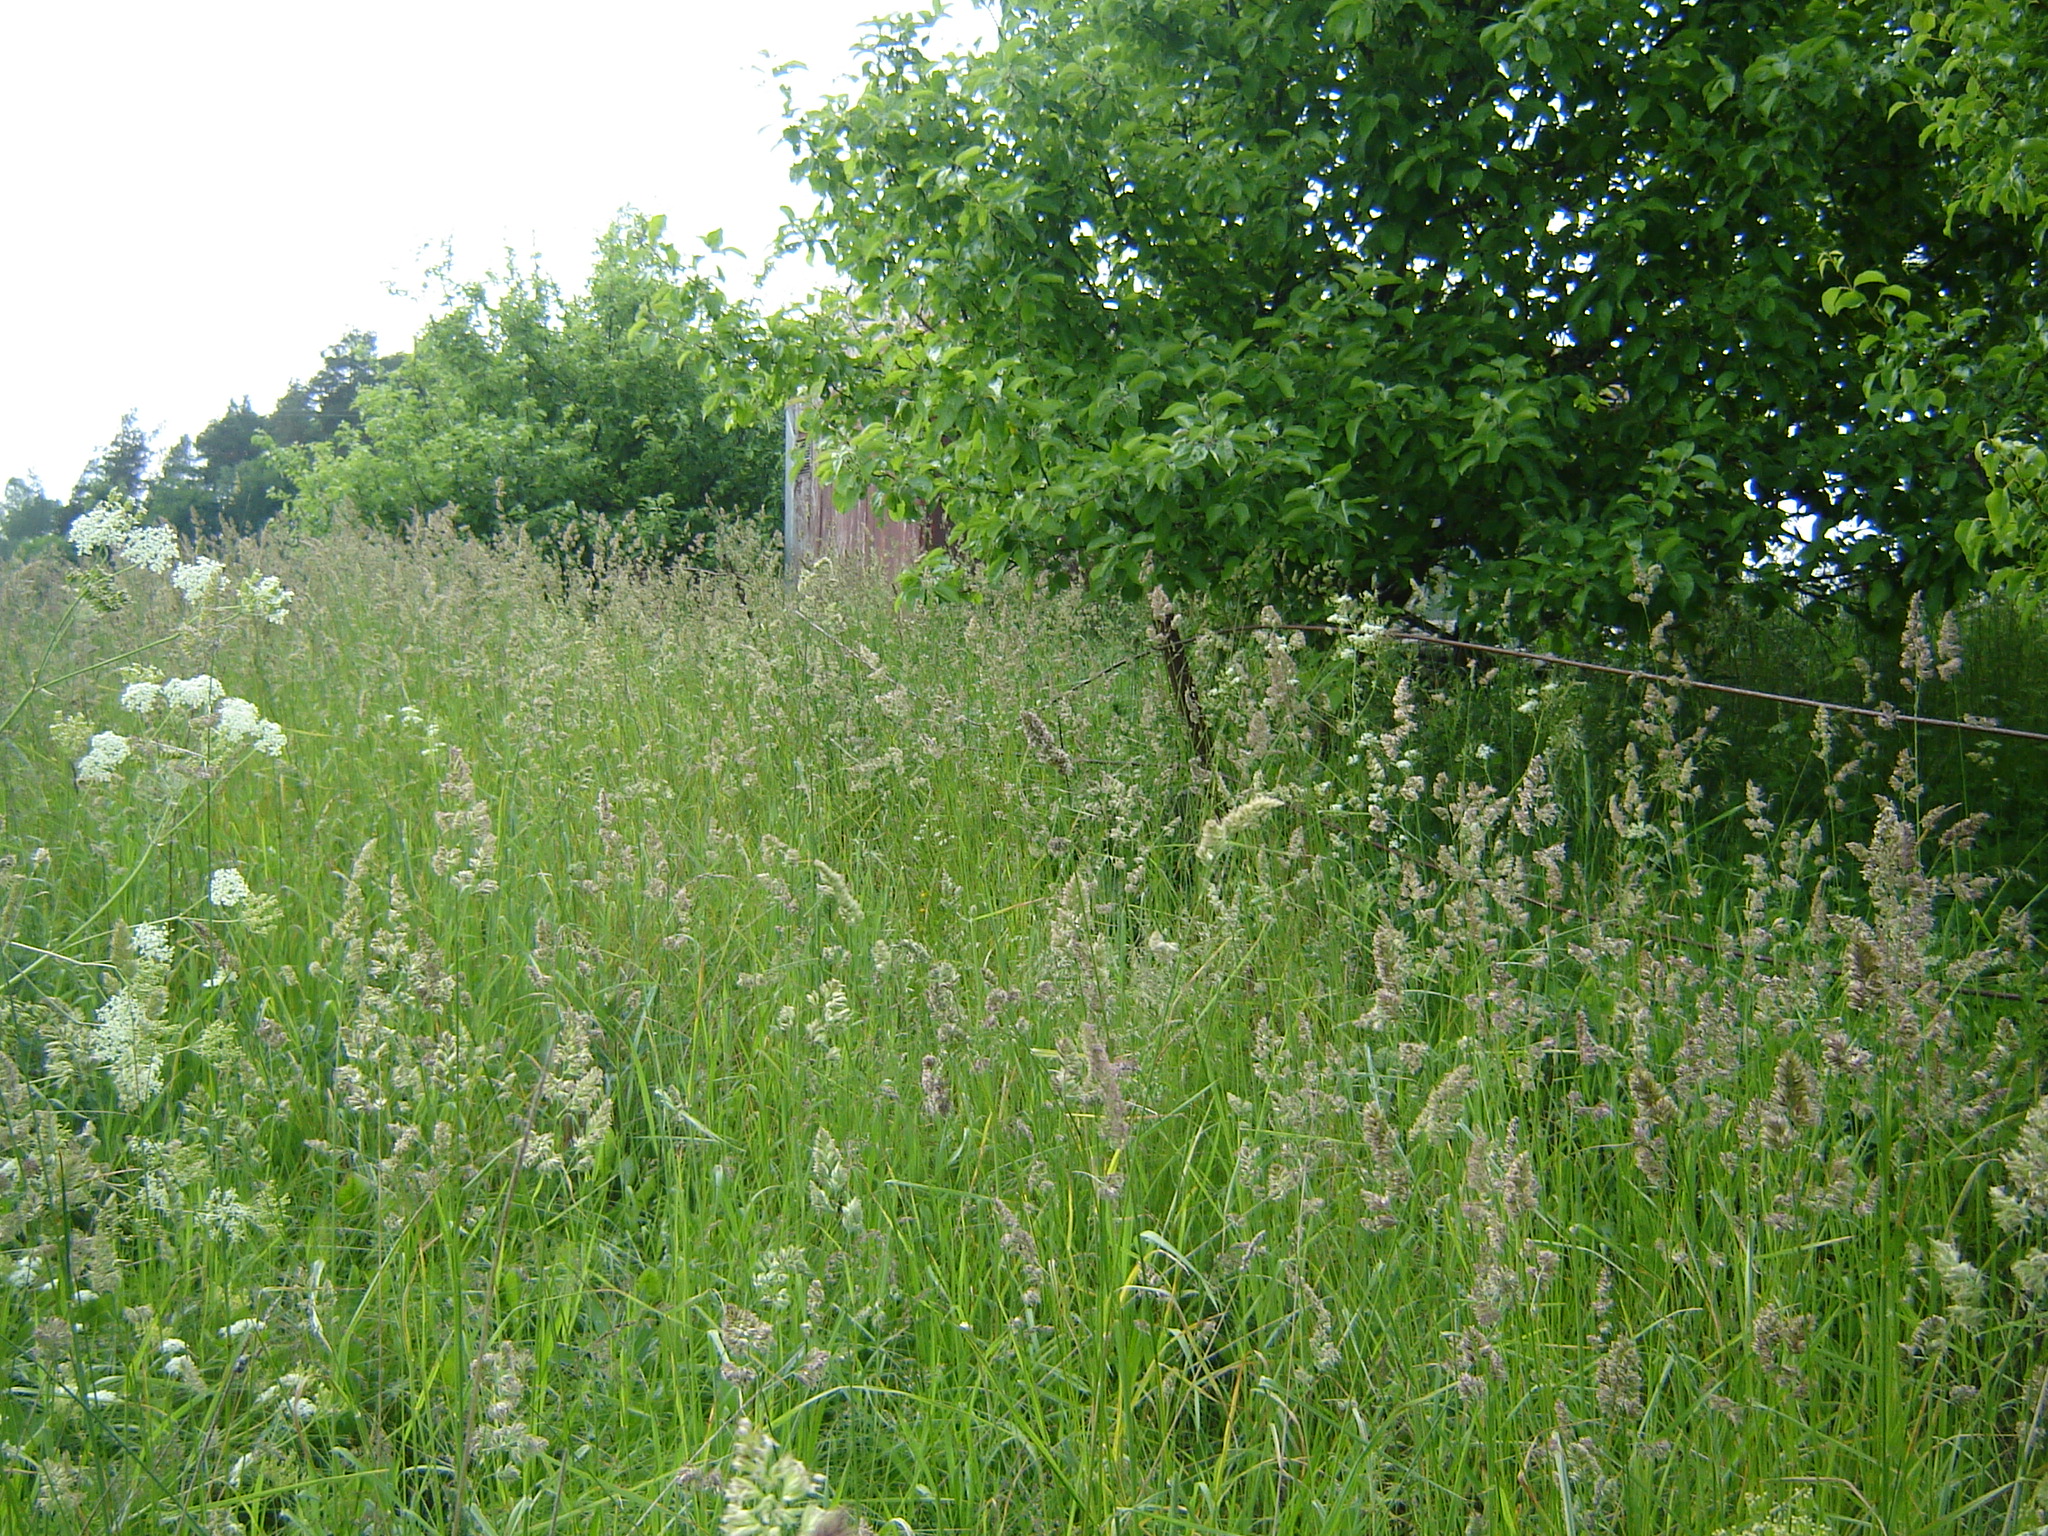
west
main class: Grassland
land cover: Grassland without tree/shrub cover
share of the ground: > 75 %
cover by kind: herbaceous plants 100 %
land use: Agriculture (excluding fallow land and kitchen gardens)
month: June
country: LT
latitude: 55.4776
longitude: 25.4870
